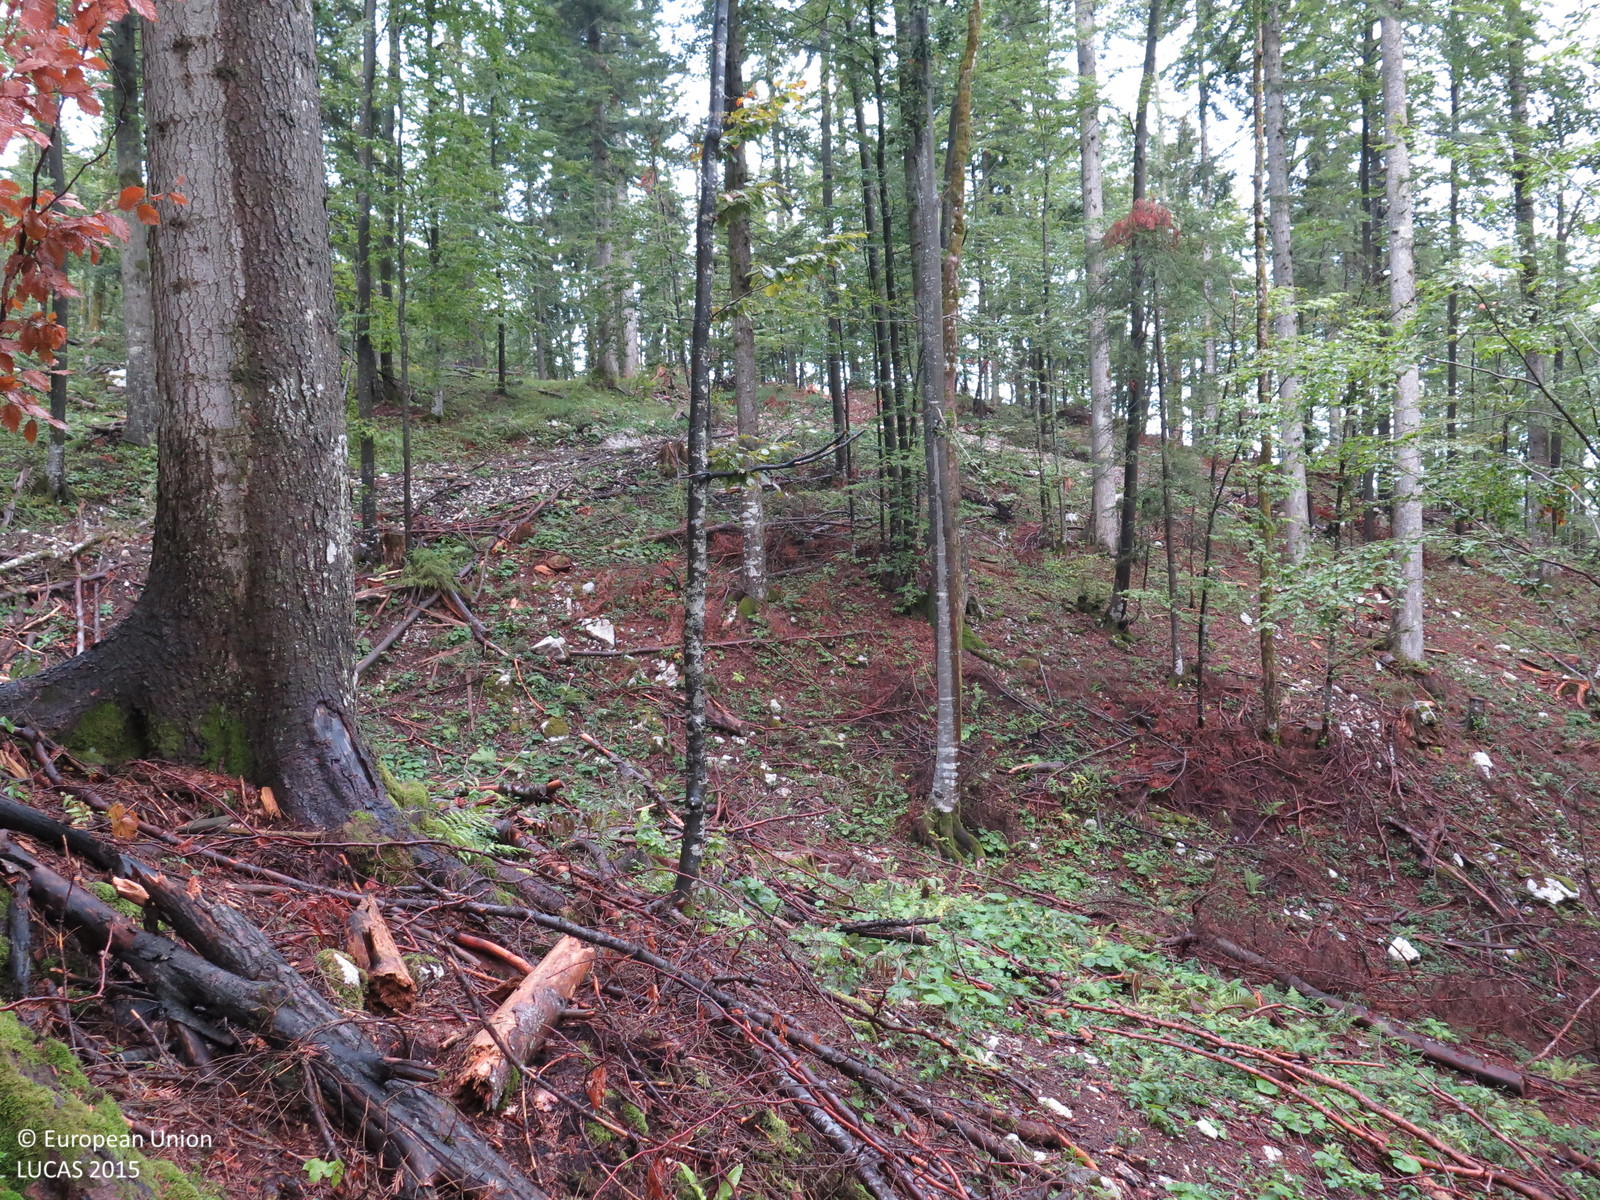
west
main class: Woodland
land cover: Other coniferous woodland
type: alpine coniferous forest
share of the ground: > 75 %
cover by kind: coniferous forest trees 90 %, broadleaved forest trees 5 %, unconsolidated bare surface 5 %
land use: Forestry
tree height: > 5 m
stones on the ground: 25 - 50 %
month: September
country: HR
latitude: 45.4545
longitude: 14.6883
